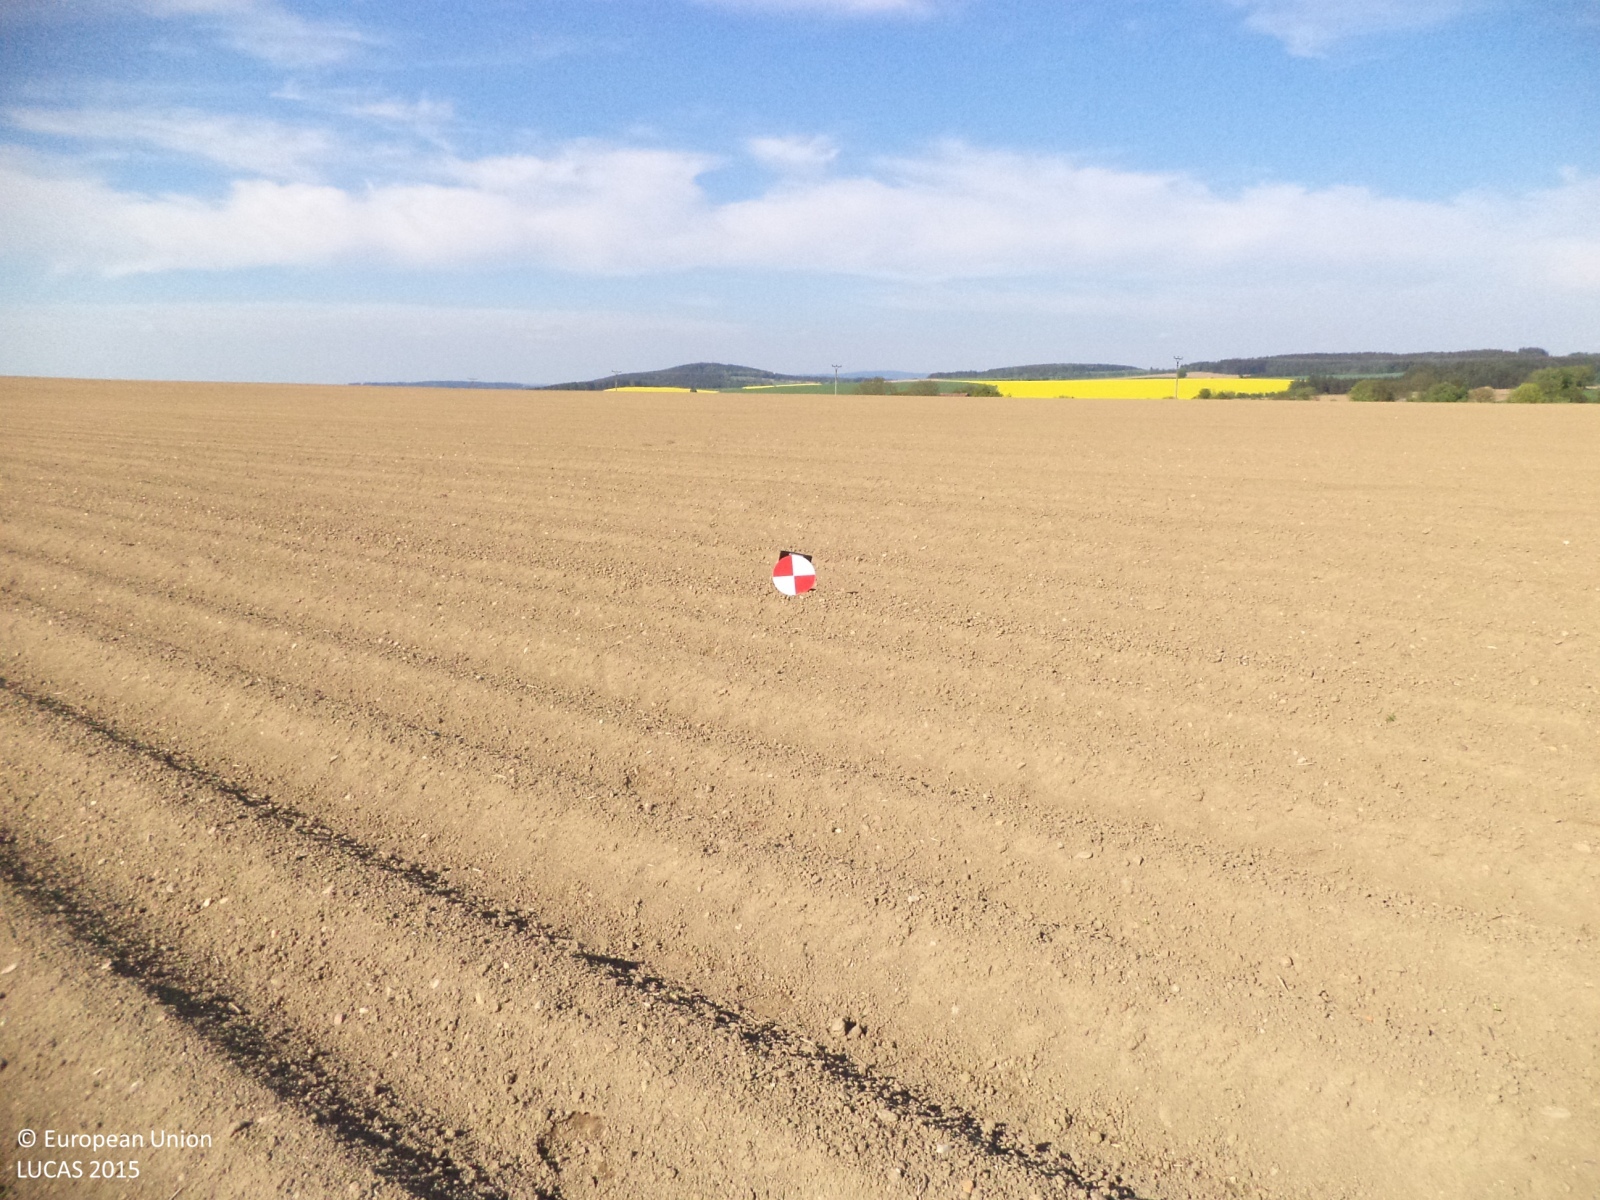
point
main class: Cropland
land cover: Potatoes
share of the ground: < 10 %
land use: Agriculture (excluding fallow land and kitchen gardens)
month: May
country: CZ
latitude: 49.4578
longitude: 15.0934
